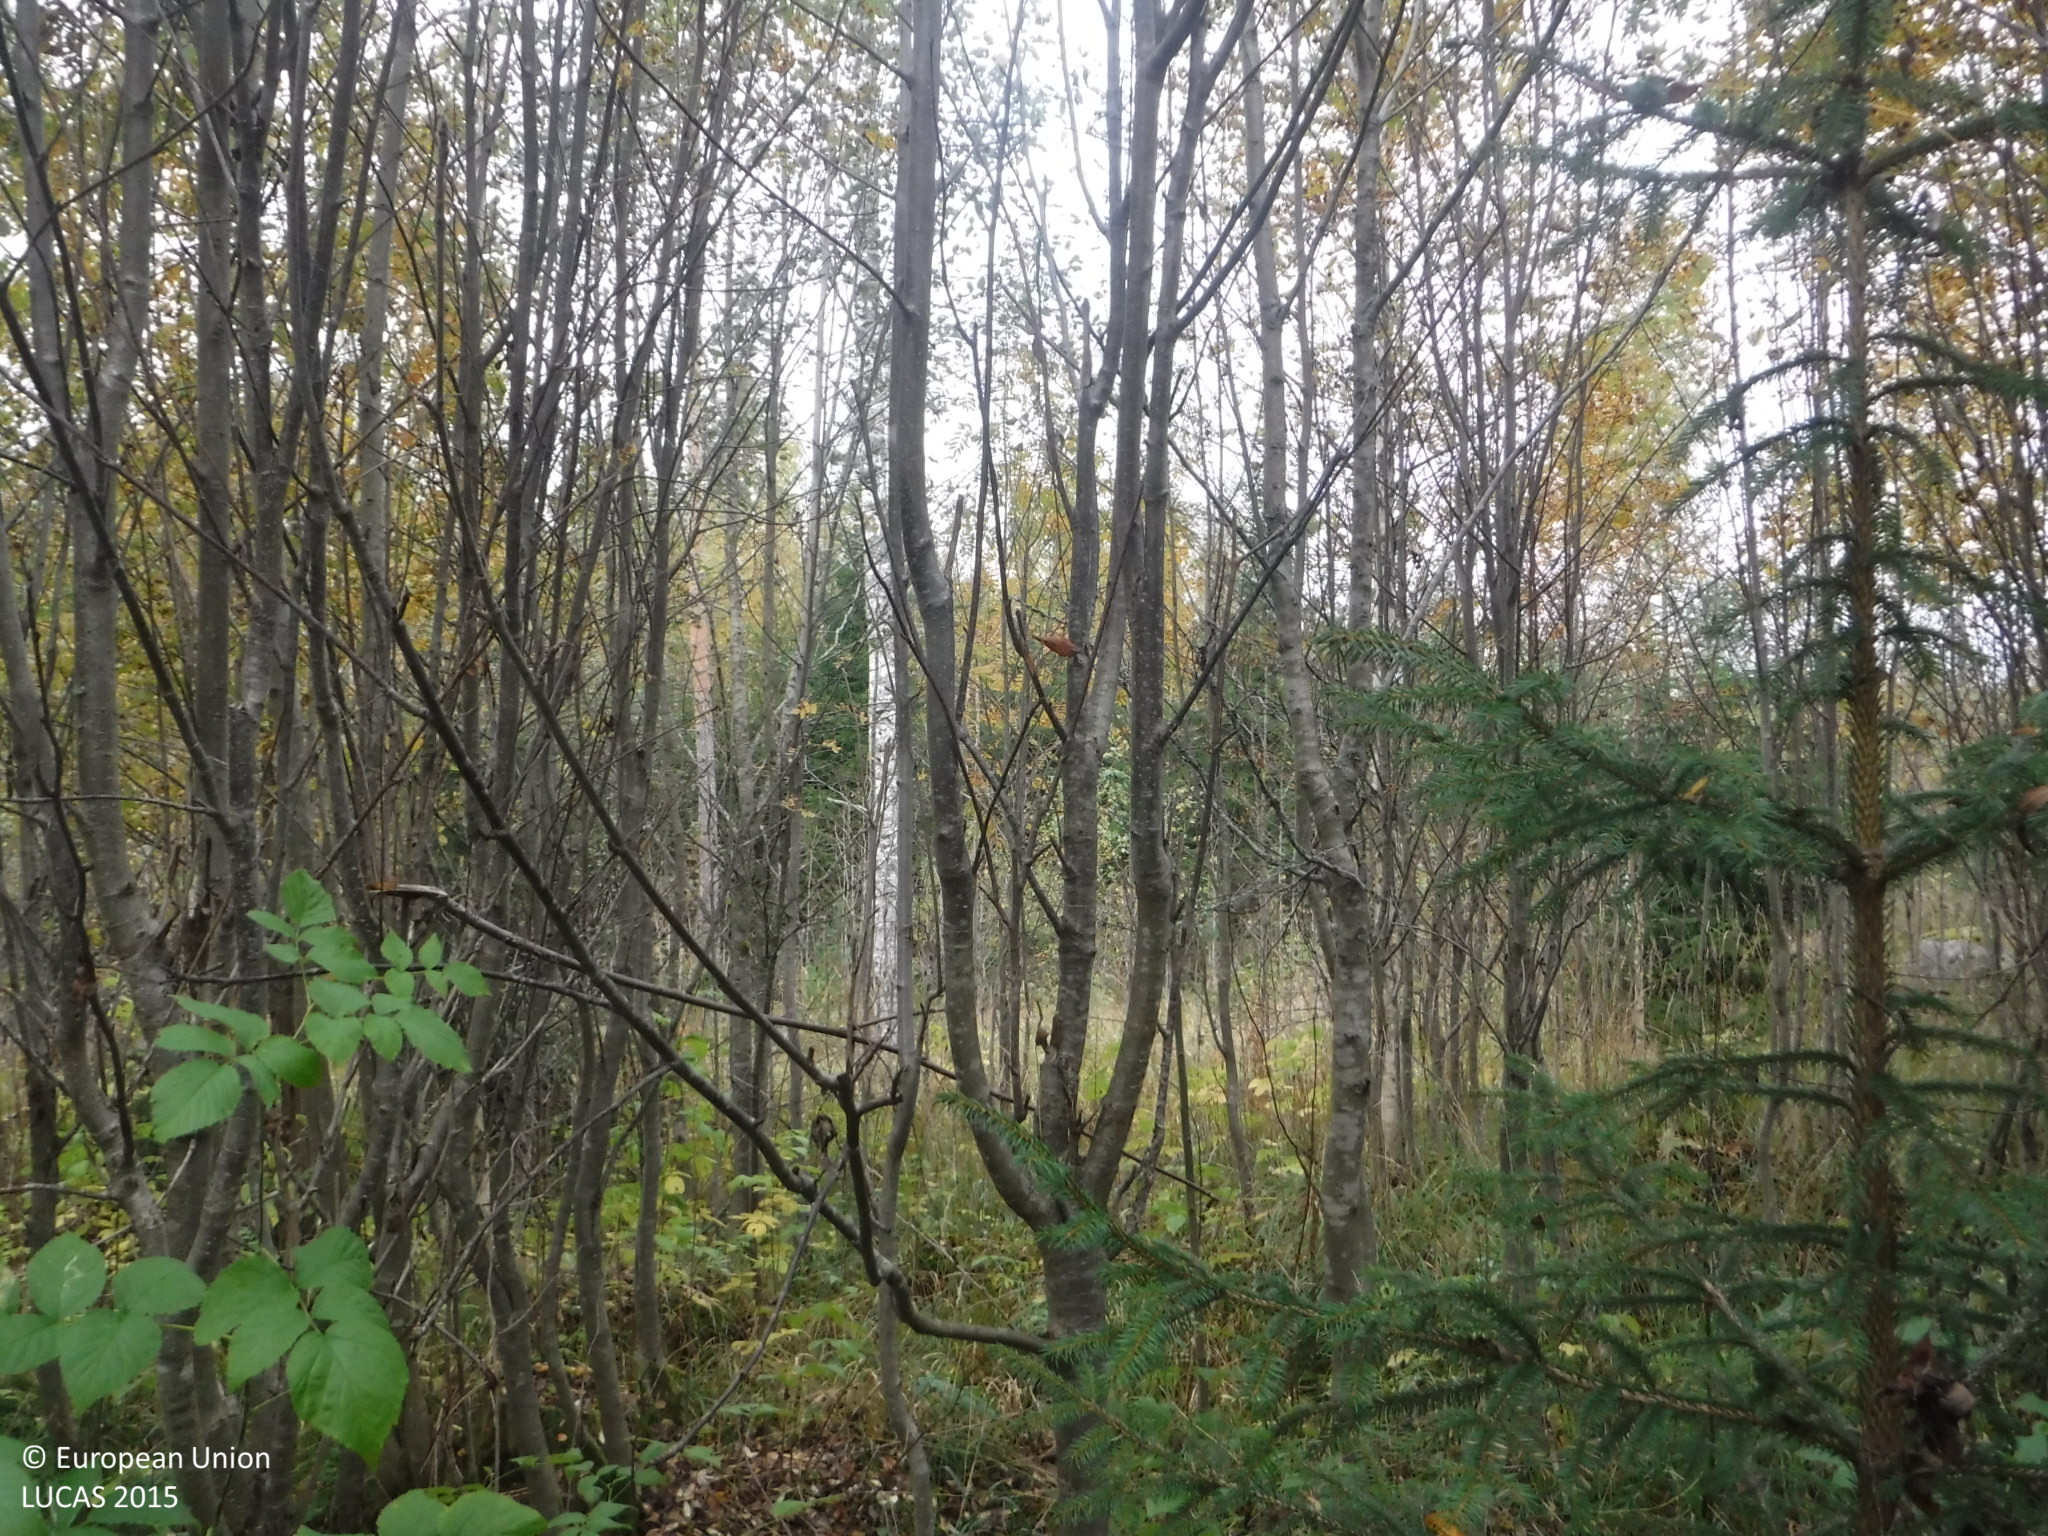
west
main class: Woodland
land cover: Broadleaved woodland
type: boreal forest
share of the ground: > 75 %
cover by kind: broadleaved forest trees 75 %, coniferous forest trees 10 %, lichens and mosses 10 %, shrubs 5 %
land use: Forestry
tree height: > 5 m
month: September
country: FI
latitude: 61.7405
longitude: 24.1182
